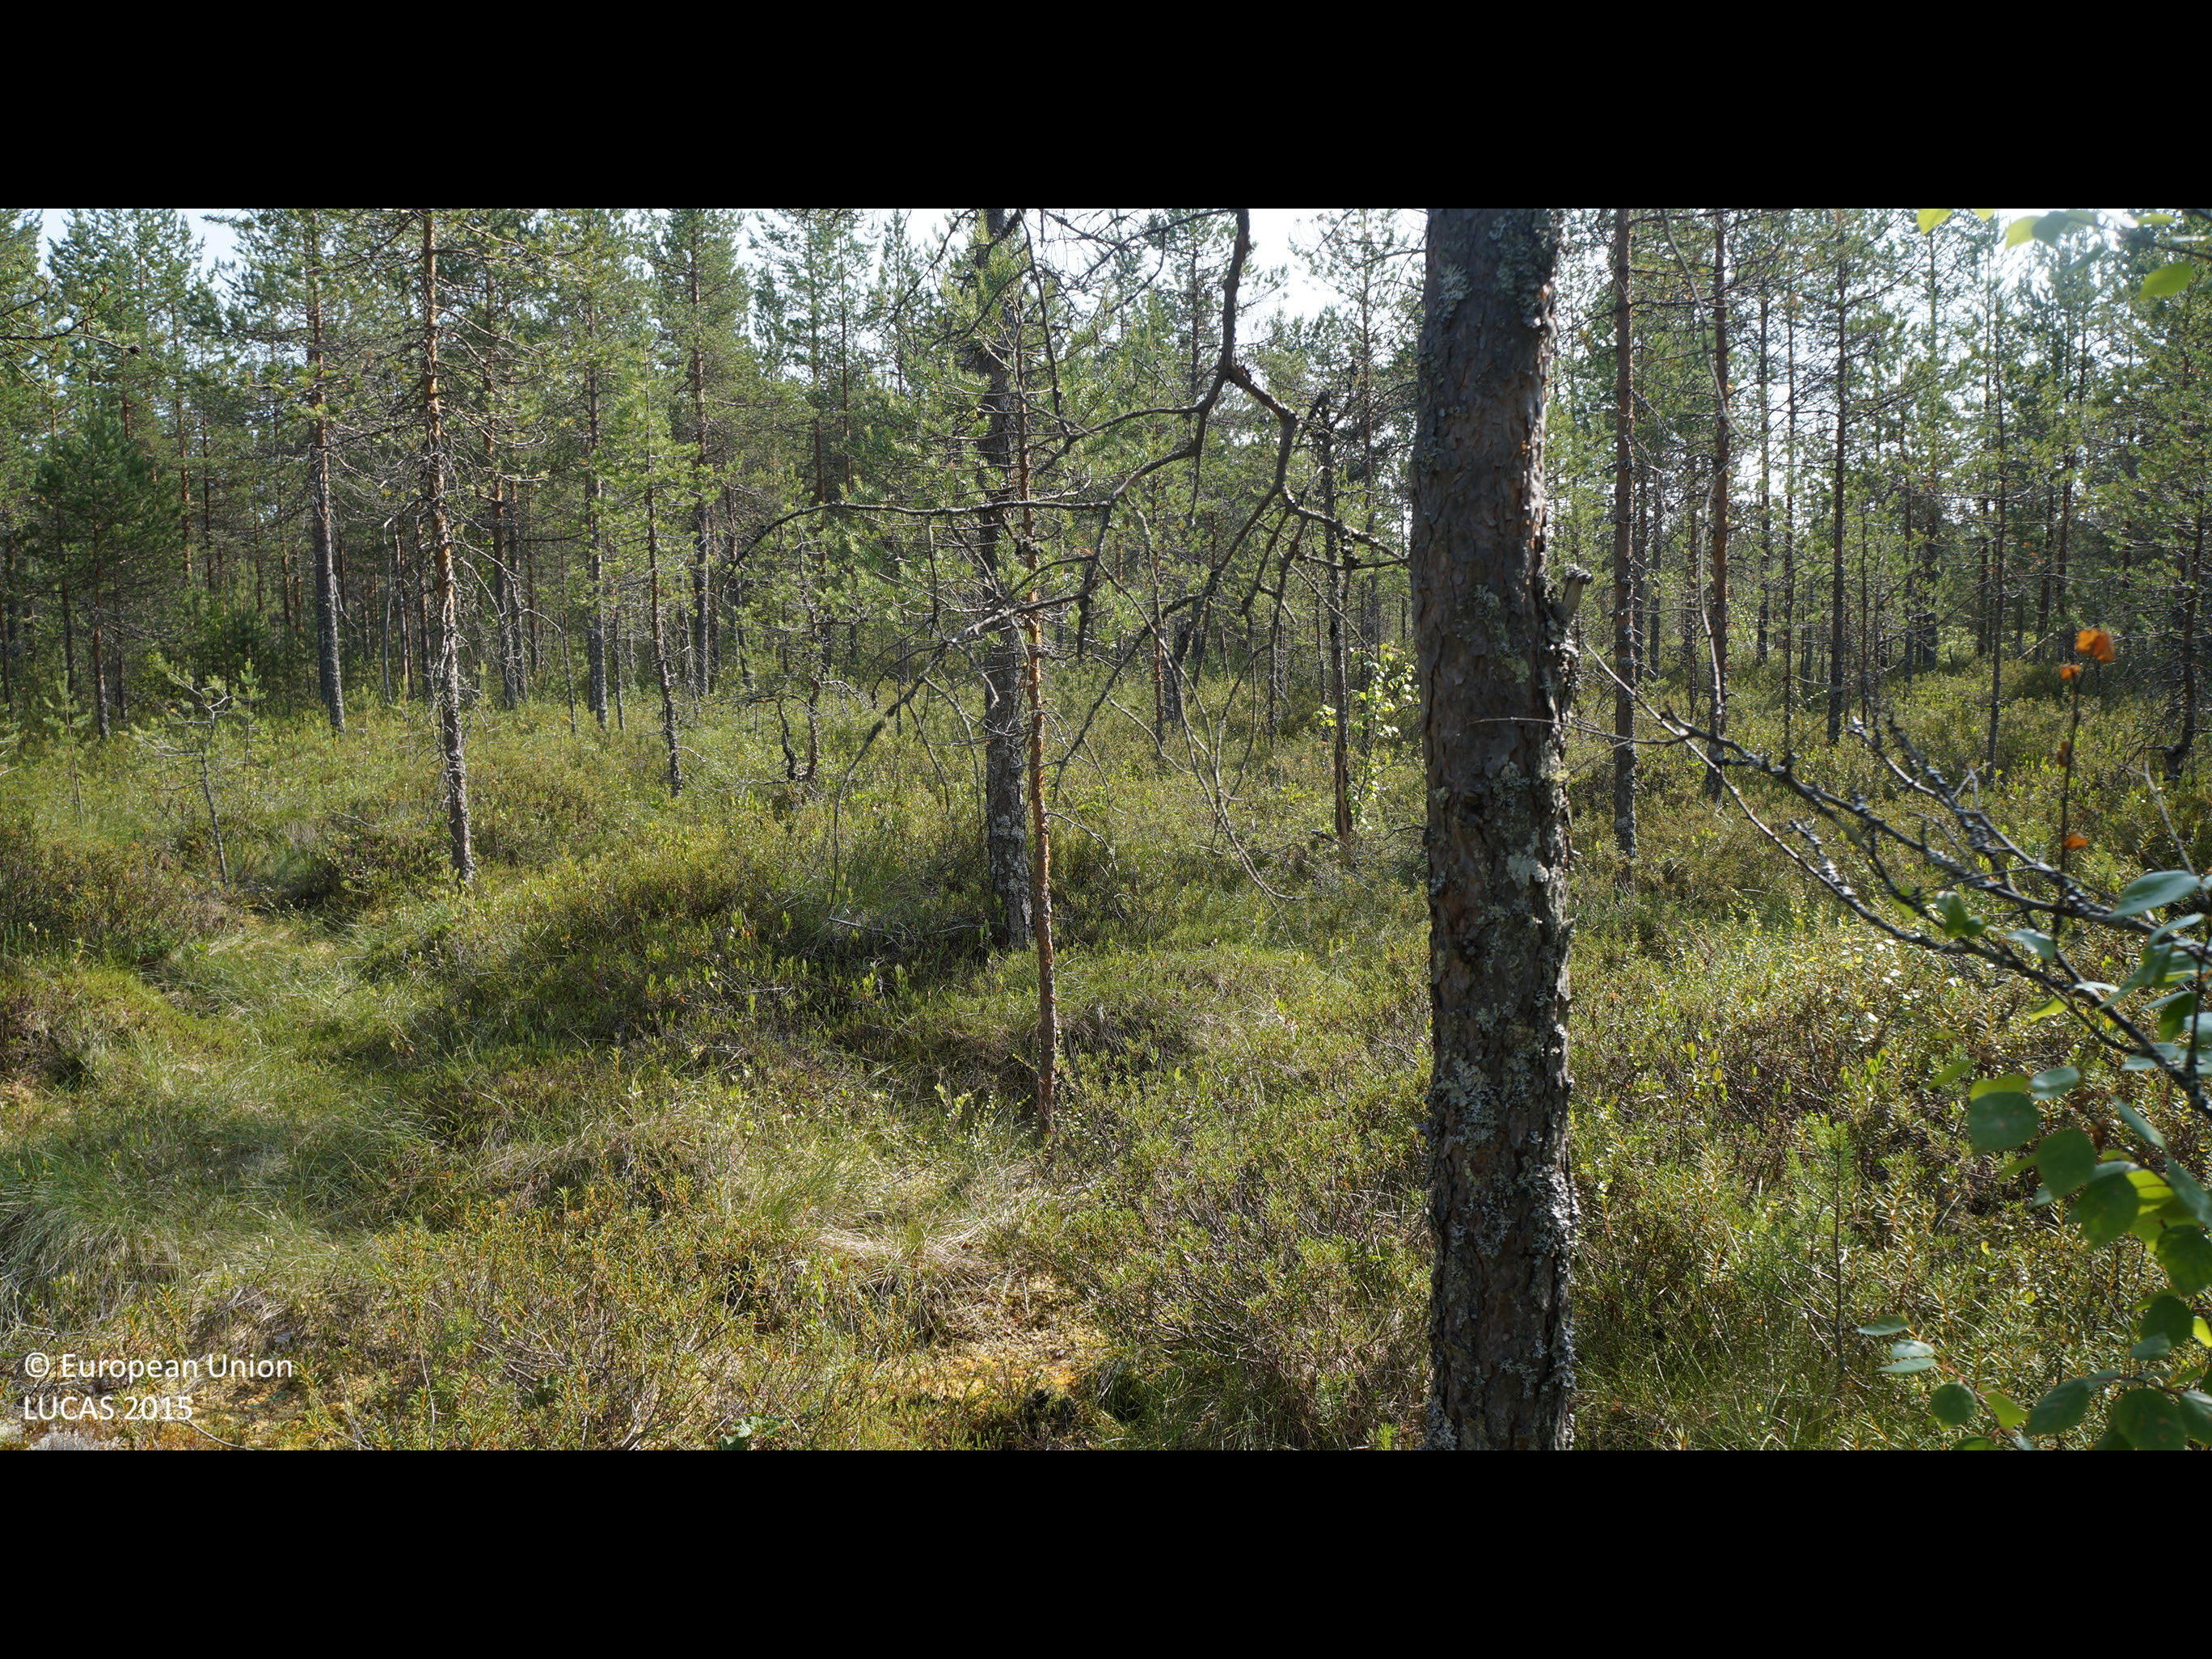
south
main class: Woodland
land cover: Pine dominated coniferous woodland
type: boreal forest
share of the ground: 25 - 50 %
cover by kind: coniferous forest trees 40 %, shrubs 40 %, lichens and mosses 20 %
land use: Forestry
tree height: > 5 m
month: July
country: FI
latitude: 64.4490
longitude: 24.4695
